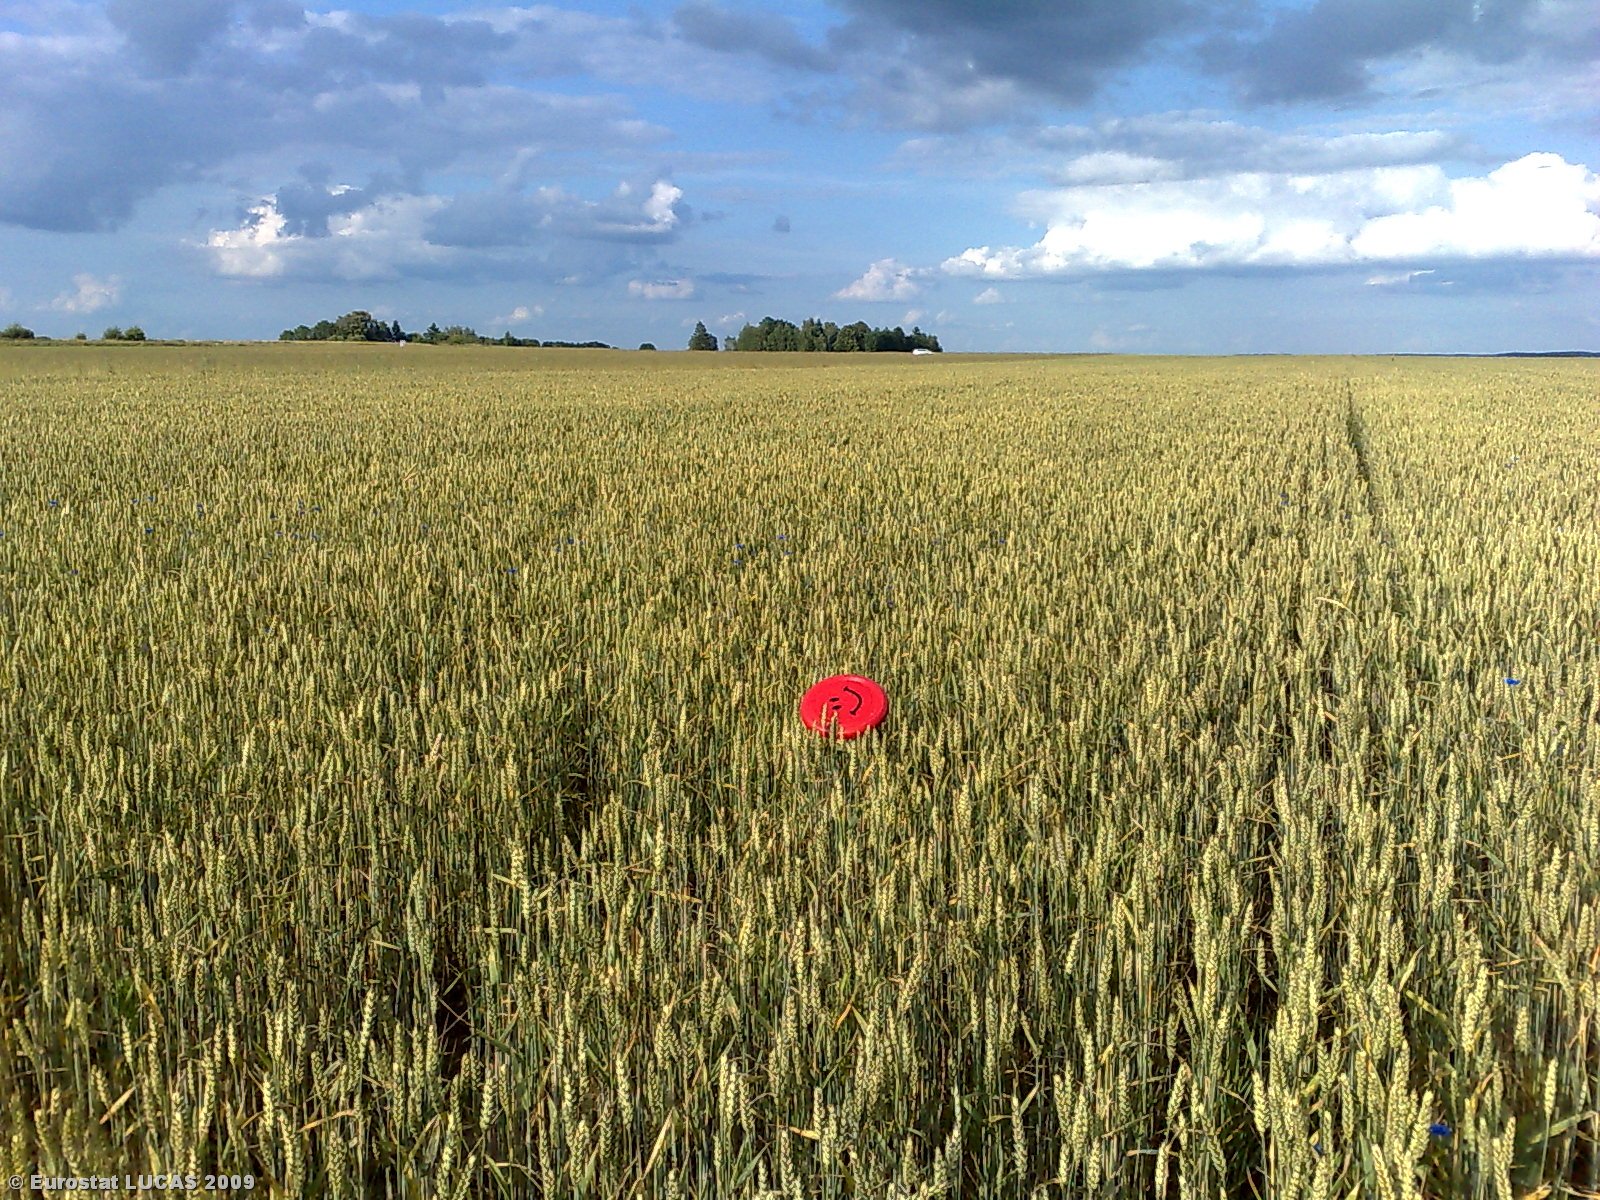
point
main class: Cropland
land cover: Common wheat
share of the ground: > 75 %
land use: Agriculture (excluding fallow land and kitchen gardens)
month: July
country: LT
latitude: 55.7414
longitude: 22.8243
